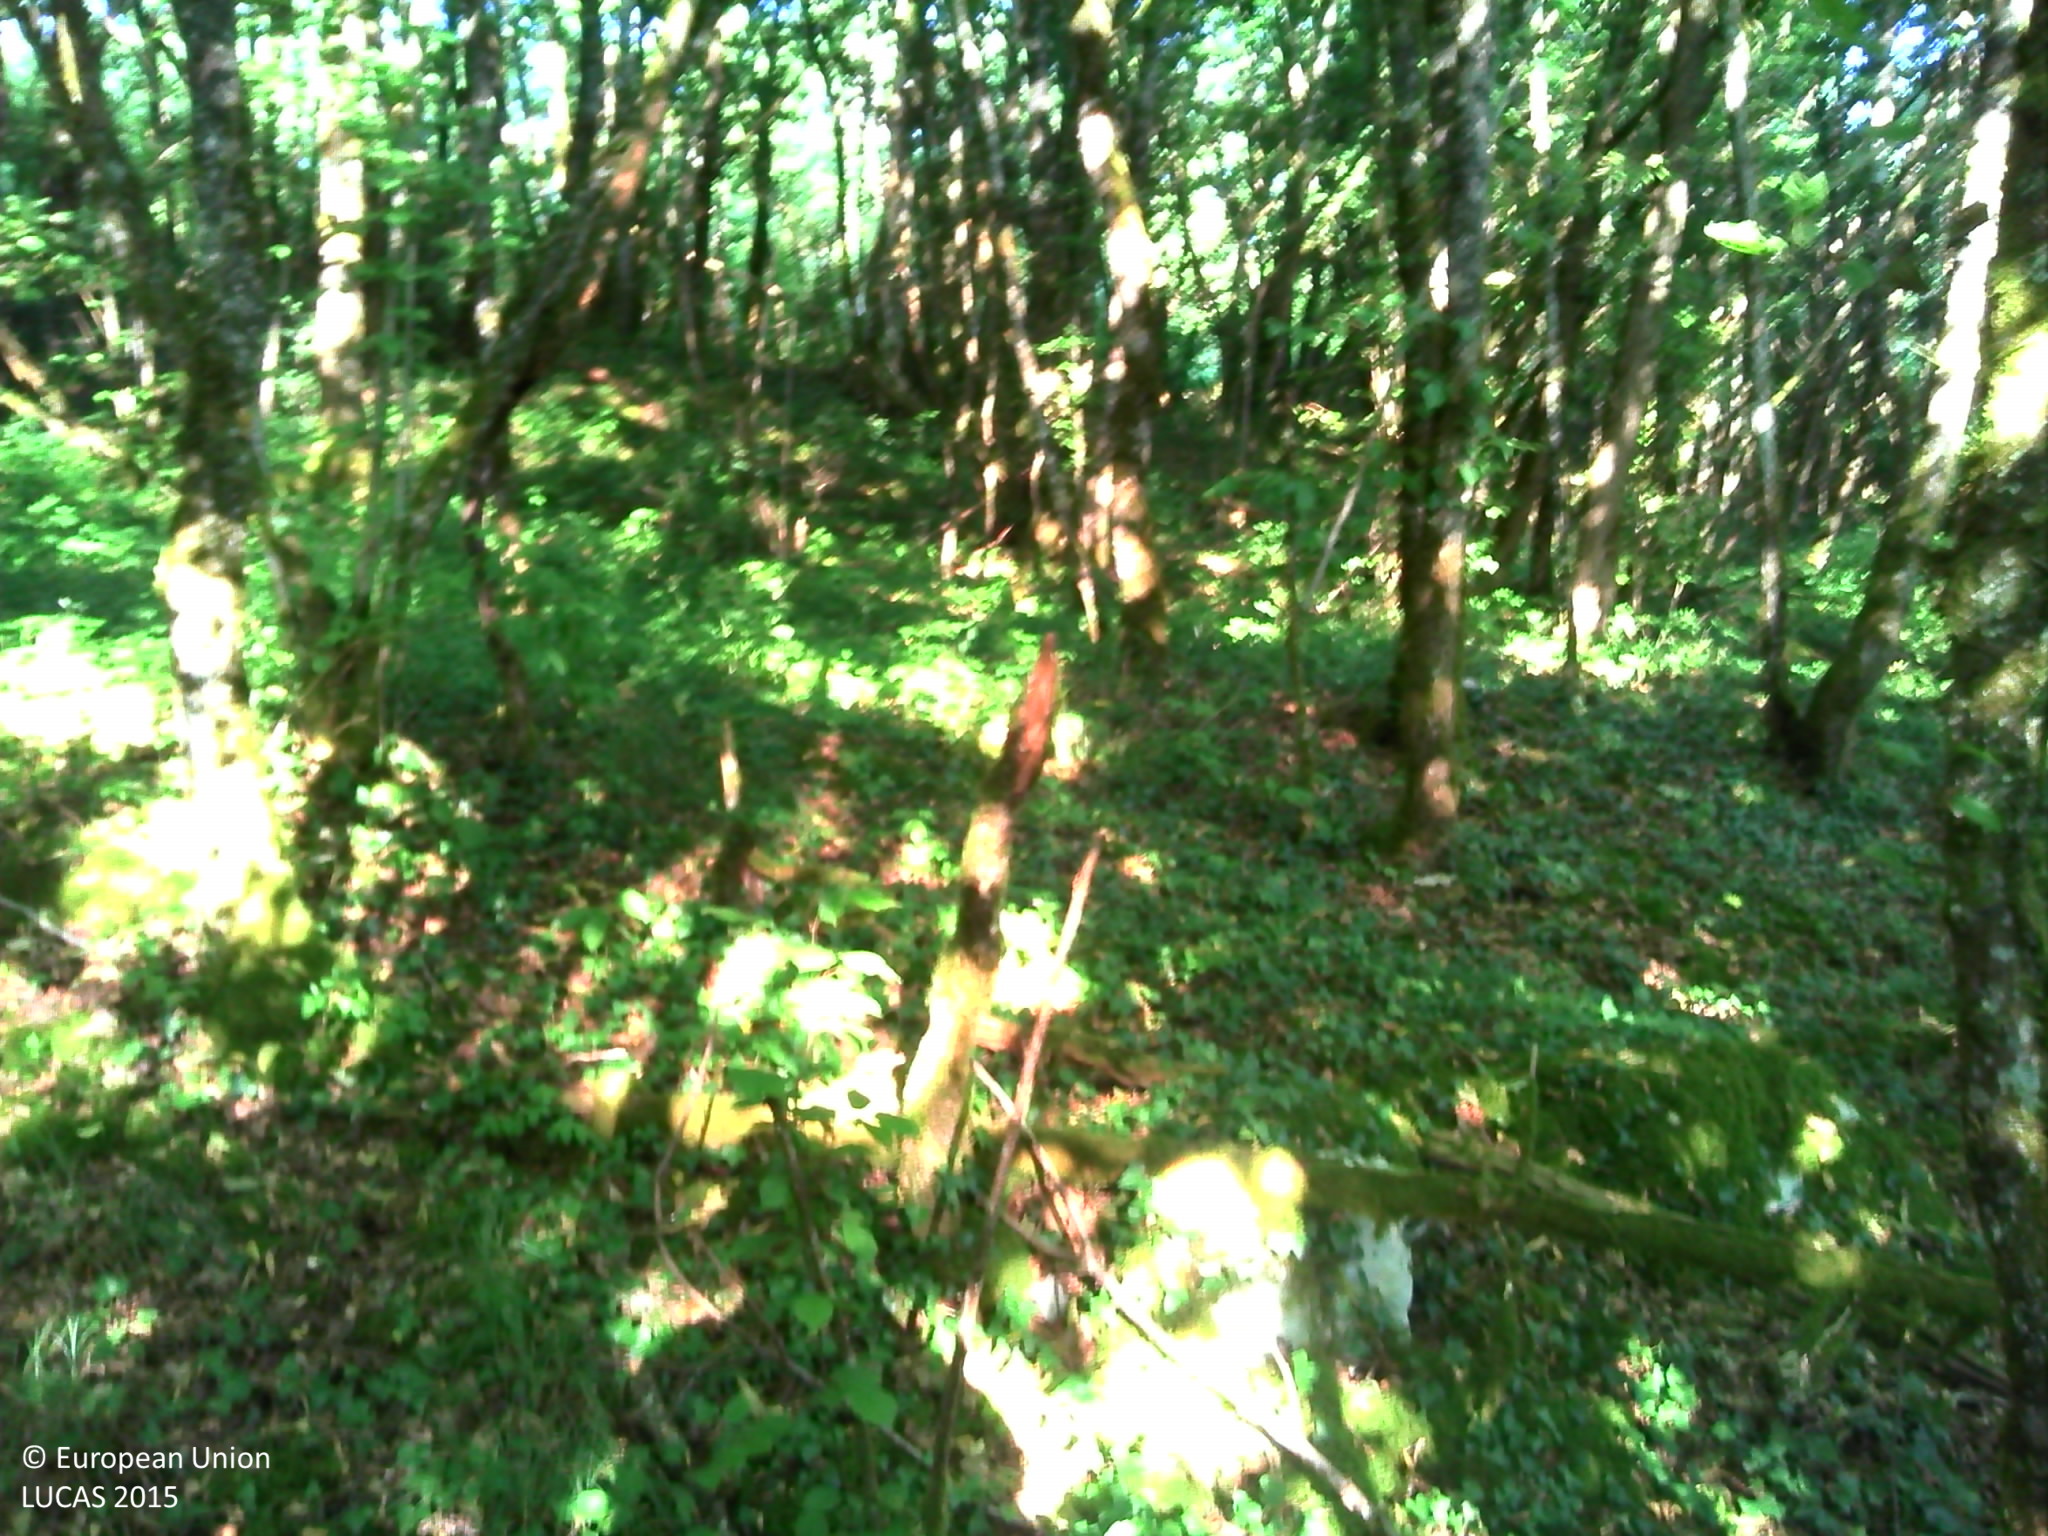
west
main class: Woodland
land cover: Broadleaved woodland
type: acidophilous oak and oak-birch forest
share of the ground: > 75 %
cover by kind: broadleaved forest trees 80 %, shrubs 10 %, herbaceous plants 5 %, lichens and mosses 5 %
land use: Forestry
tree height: > 5 m
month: July
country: FR
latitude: 45.3229
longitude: 1.0485
